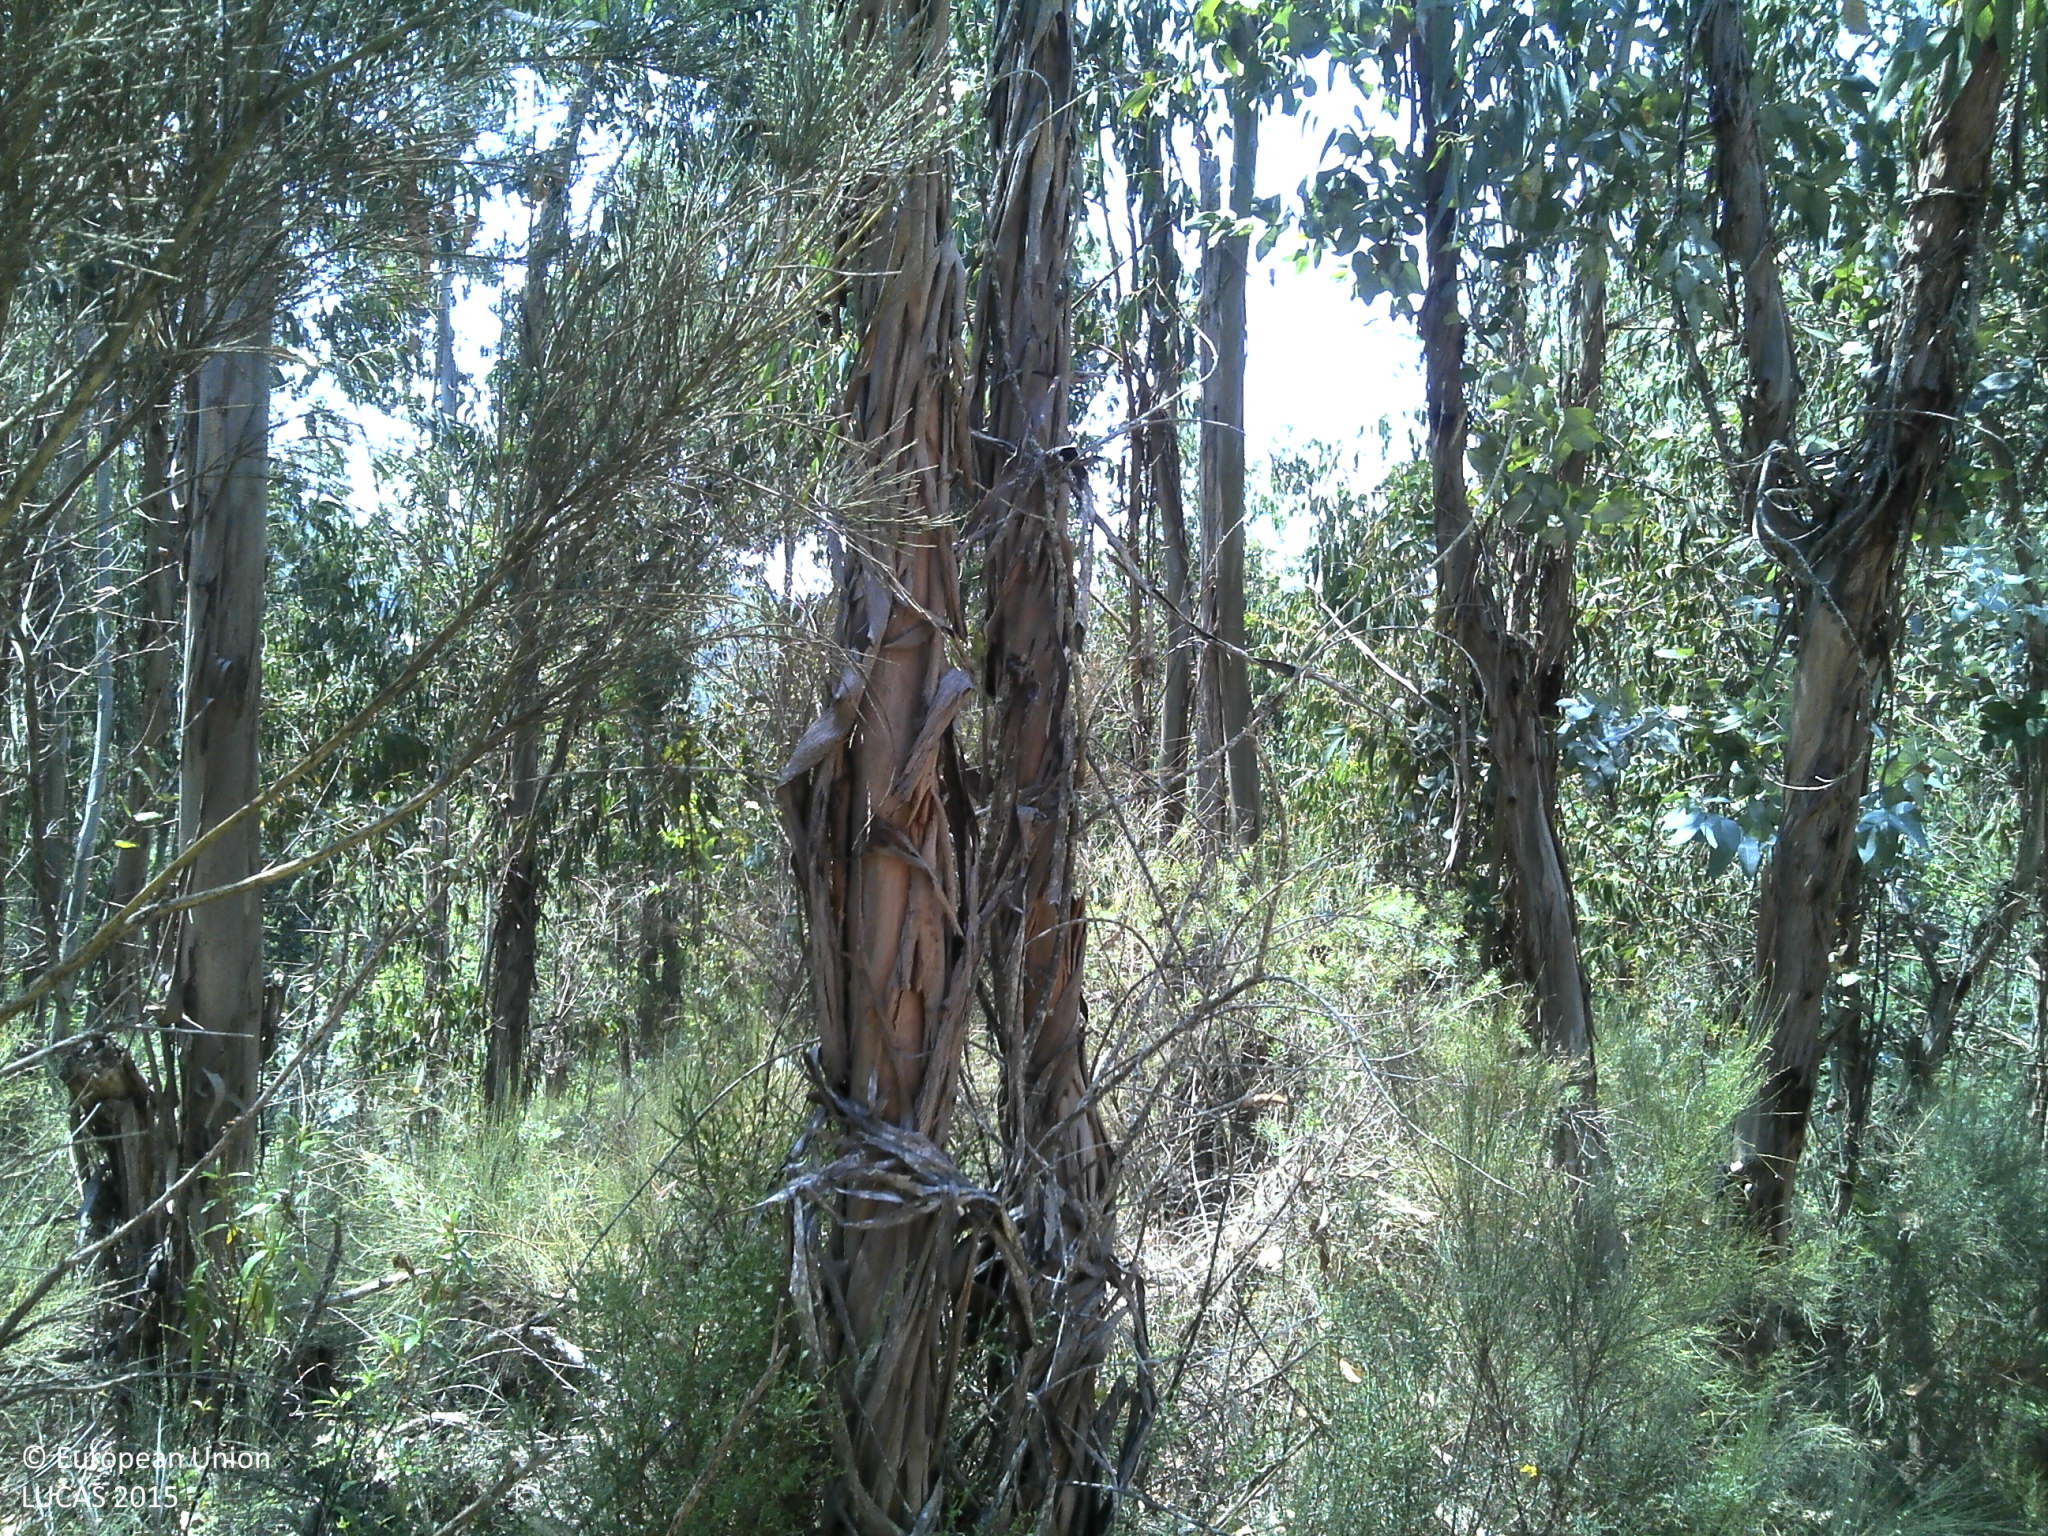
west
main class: Woodland
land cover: Broadleaved woodland
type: exotic forest
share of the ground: 50 - 75 %
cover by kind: broadleaved forest trees 75 %, shrubs 20 %, unconsolidated bare surface 5 %
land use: Forestry
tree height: > 5 m
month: July
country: PT
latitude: 40.4029
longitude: -7.9725
